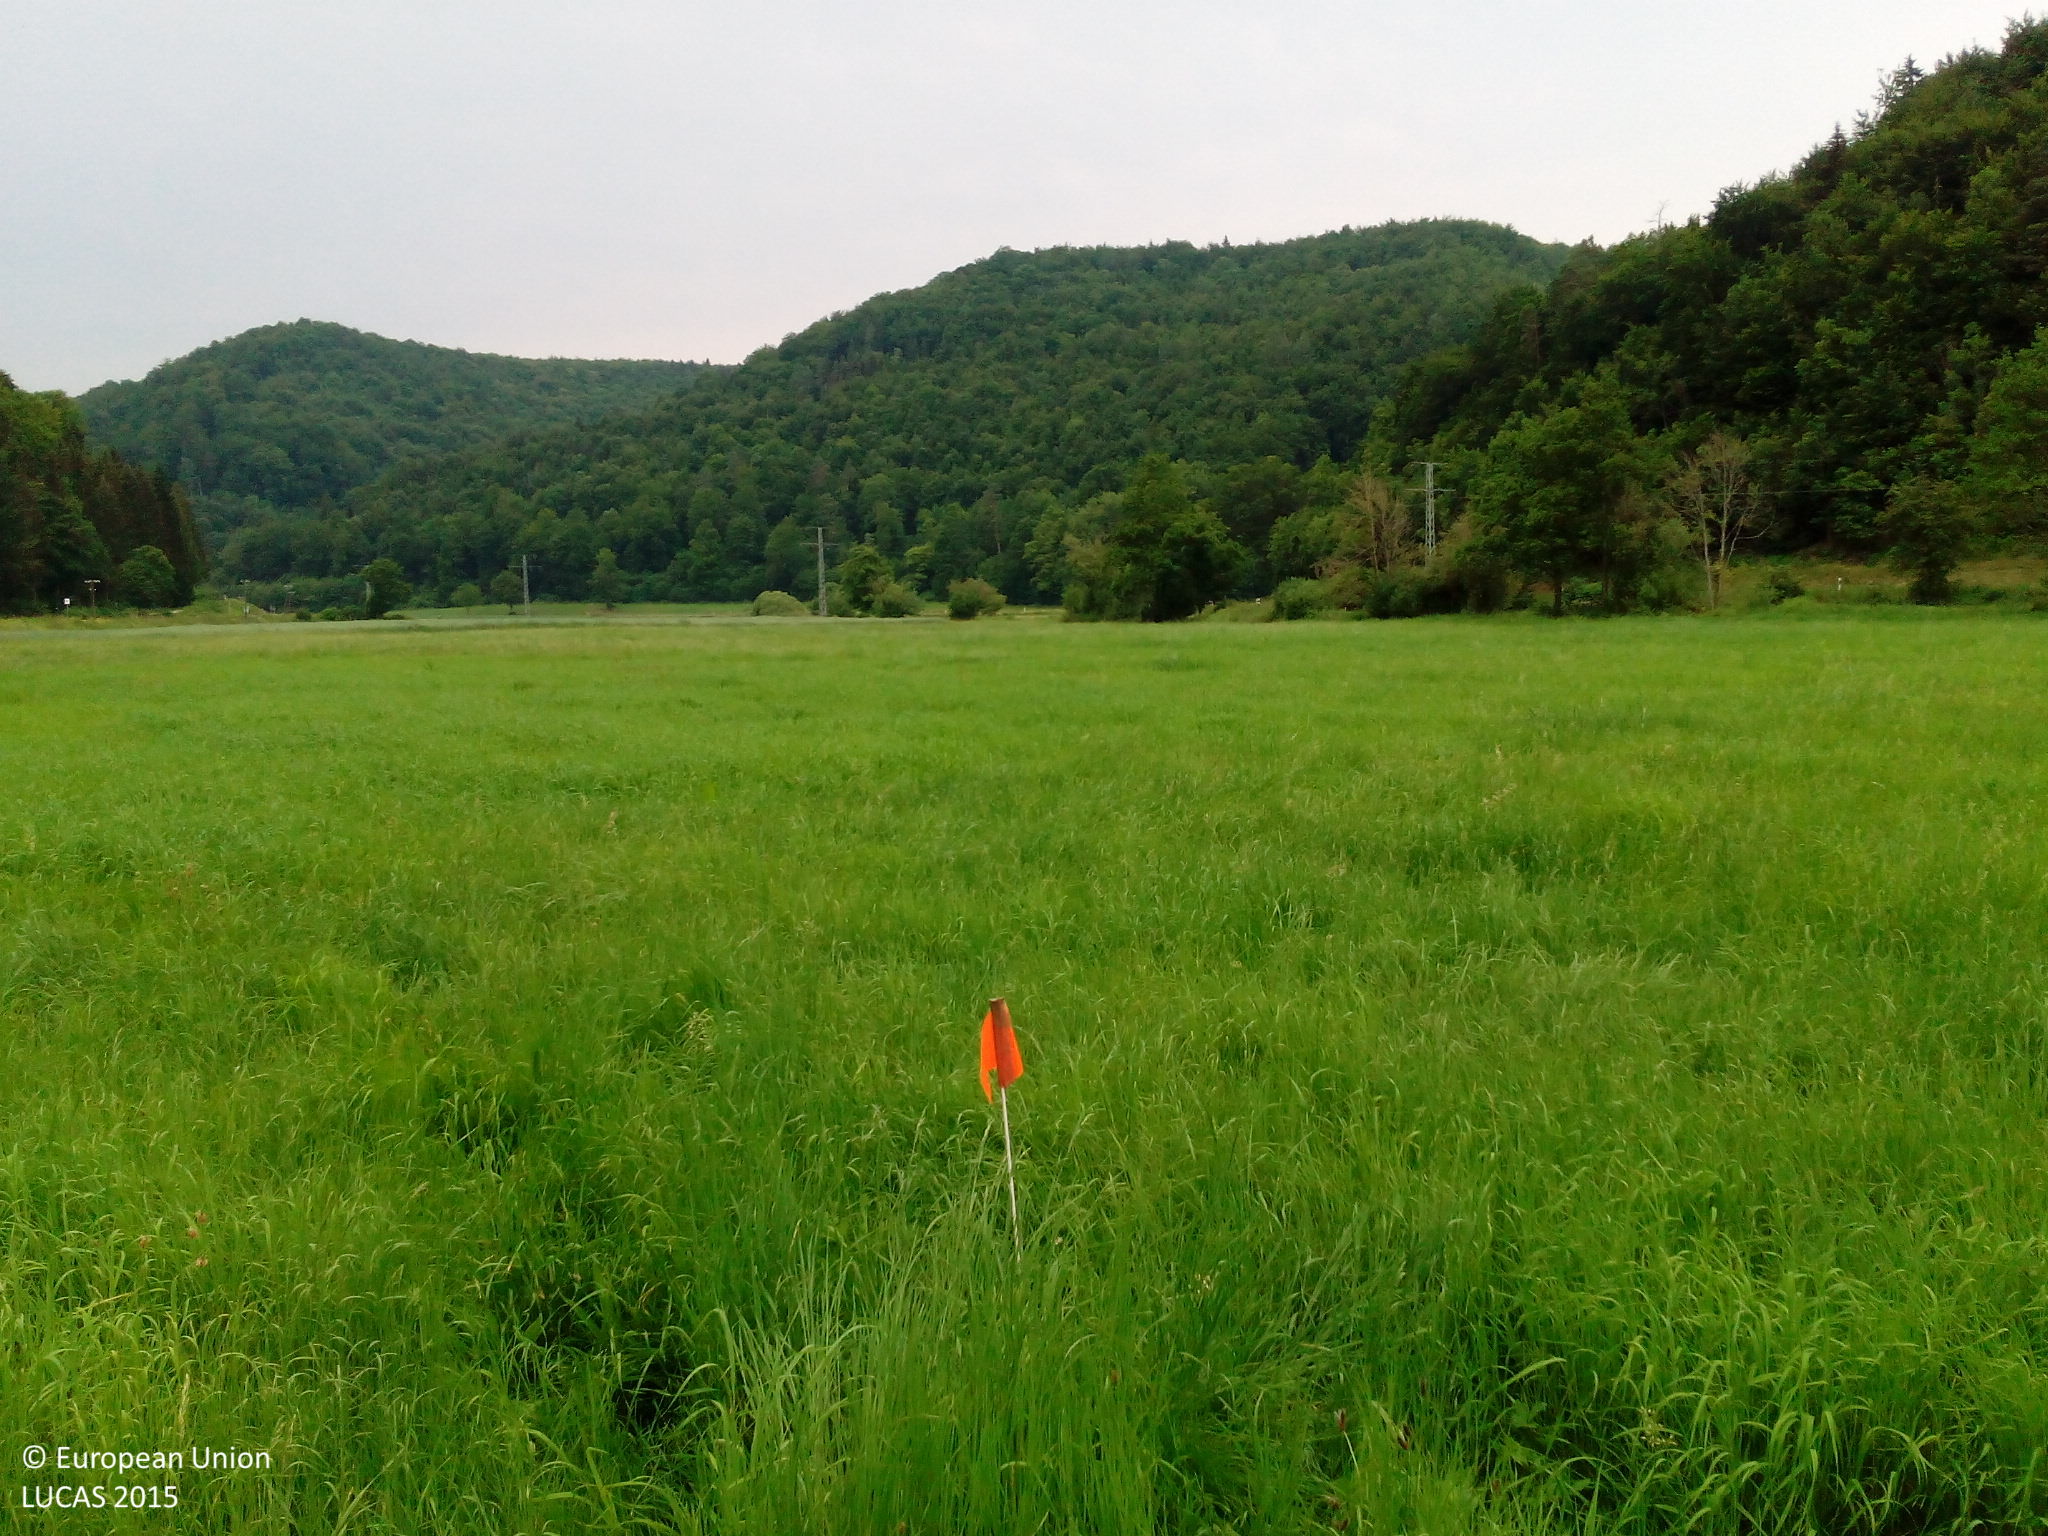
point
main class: Grassland
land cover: Grassland without tree/shrub cover
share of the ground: > 75 %
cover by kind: herbaceous plants 100 %
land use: Agriculture (excluding fallow land and kitchen gardens)
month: July
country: DE
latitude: 48.3670
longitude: 9.6897
